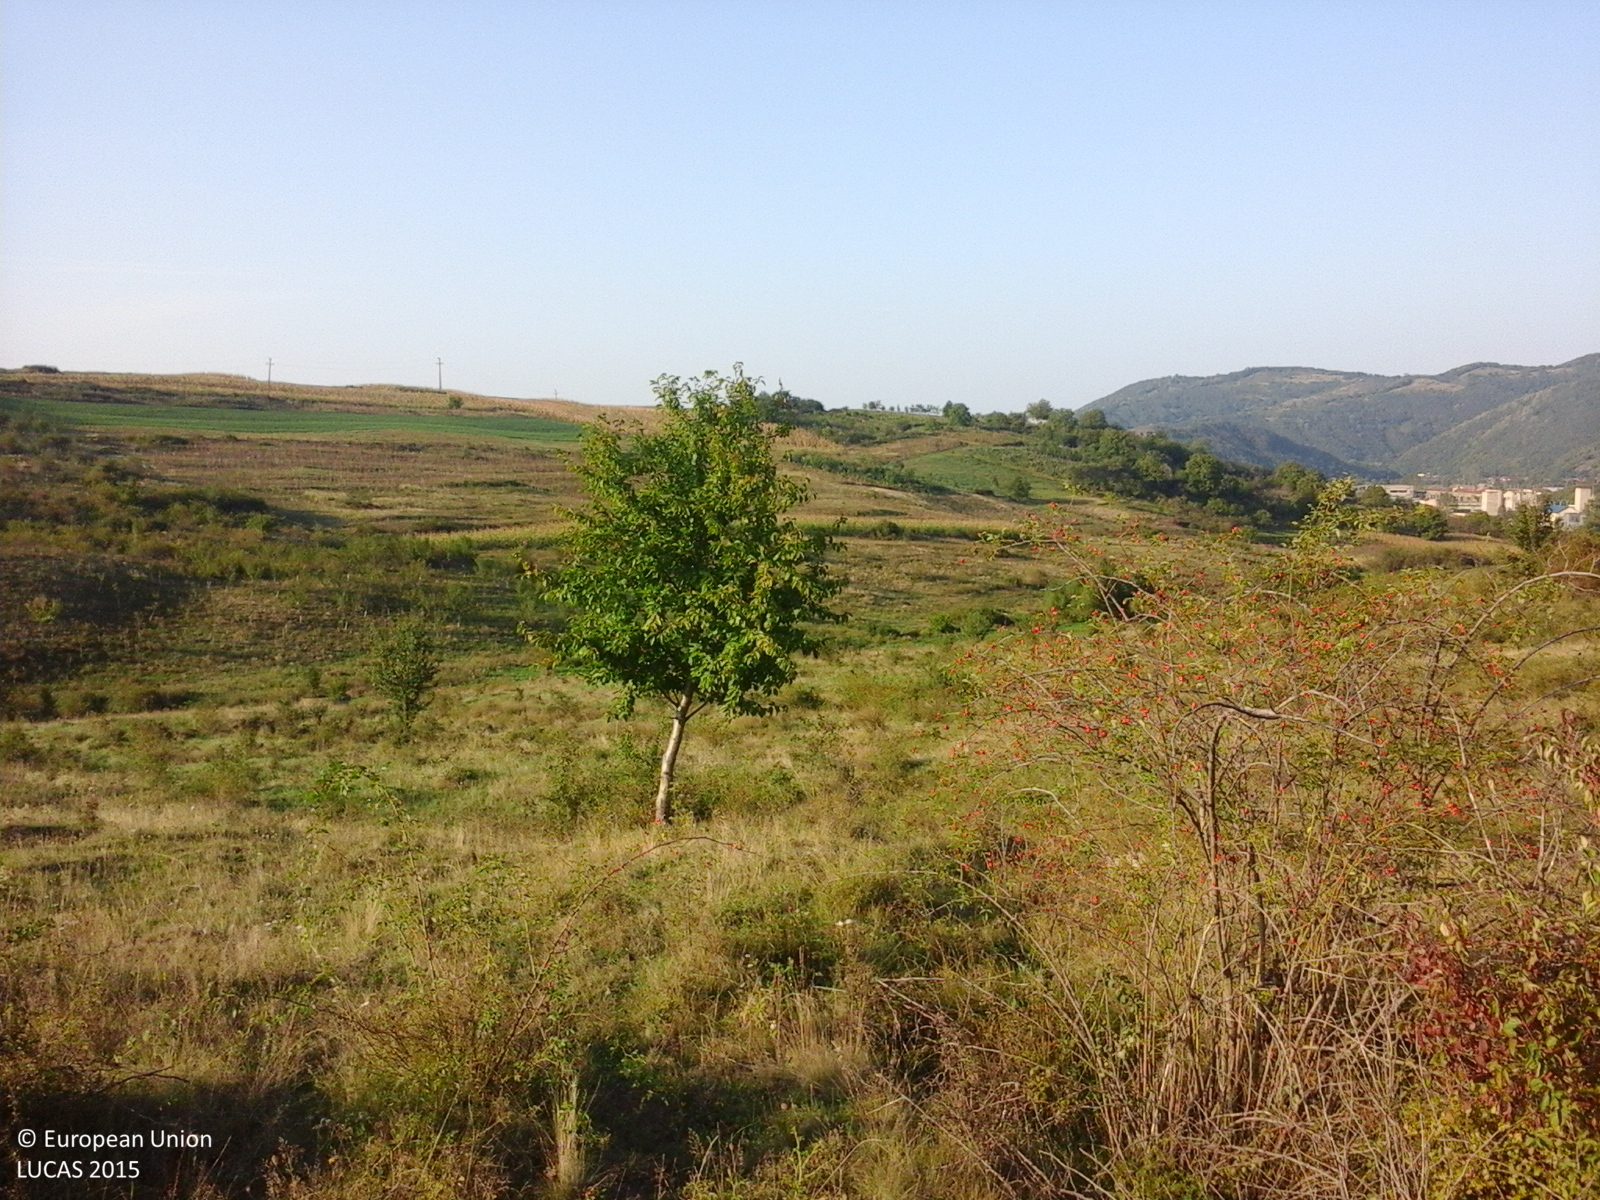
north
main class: Grassland
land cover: Grassland with sparse tree/shrub cover
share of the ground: > 75 %
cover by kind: herbaceous plants 90 %, broadleaved forest trees 5 %, shrubs 5 %
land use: Agriculture (excluding fallow land and kitchen gardens)
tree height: < 5 m
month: September
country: RO
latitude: 47.2422
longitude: 22.7552
